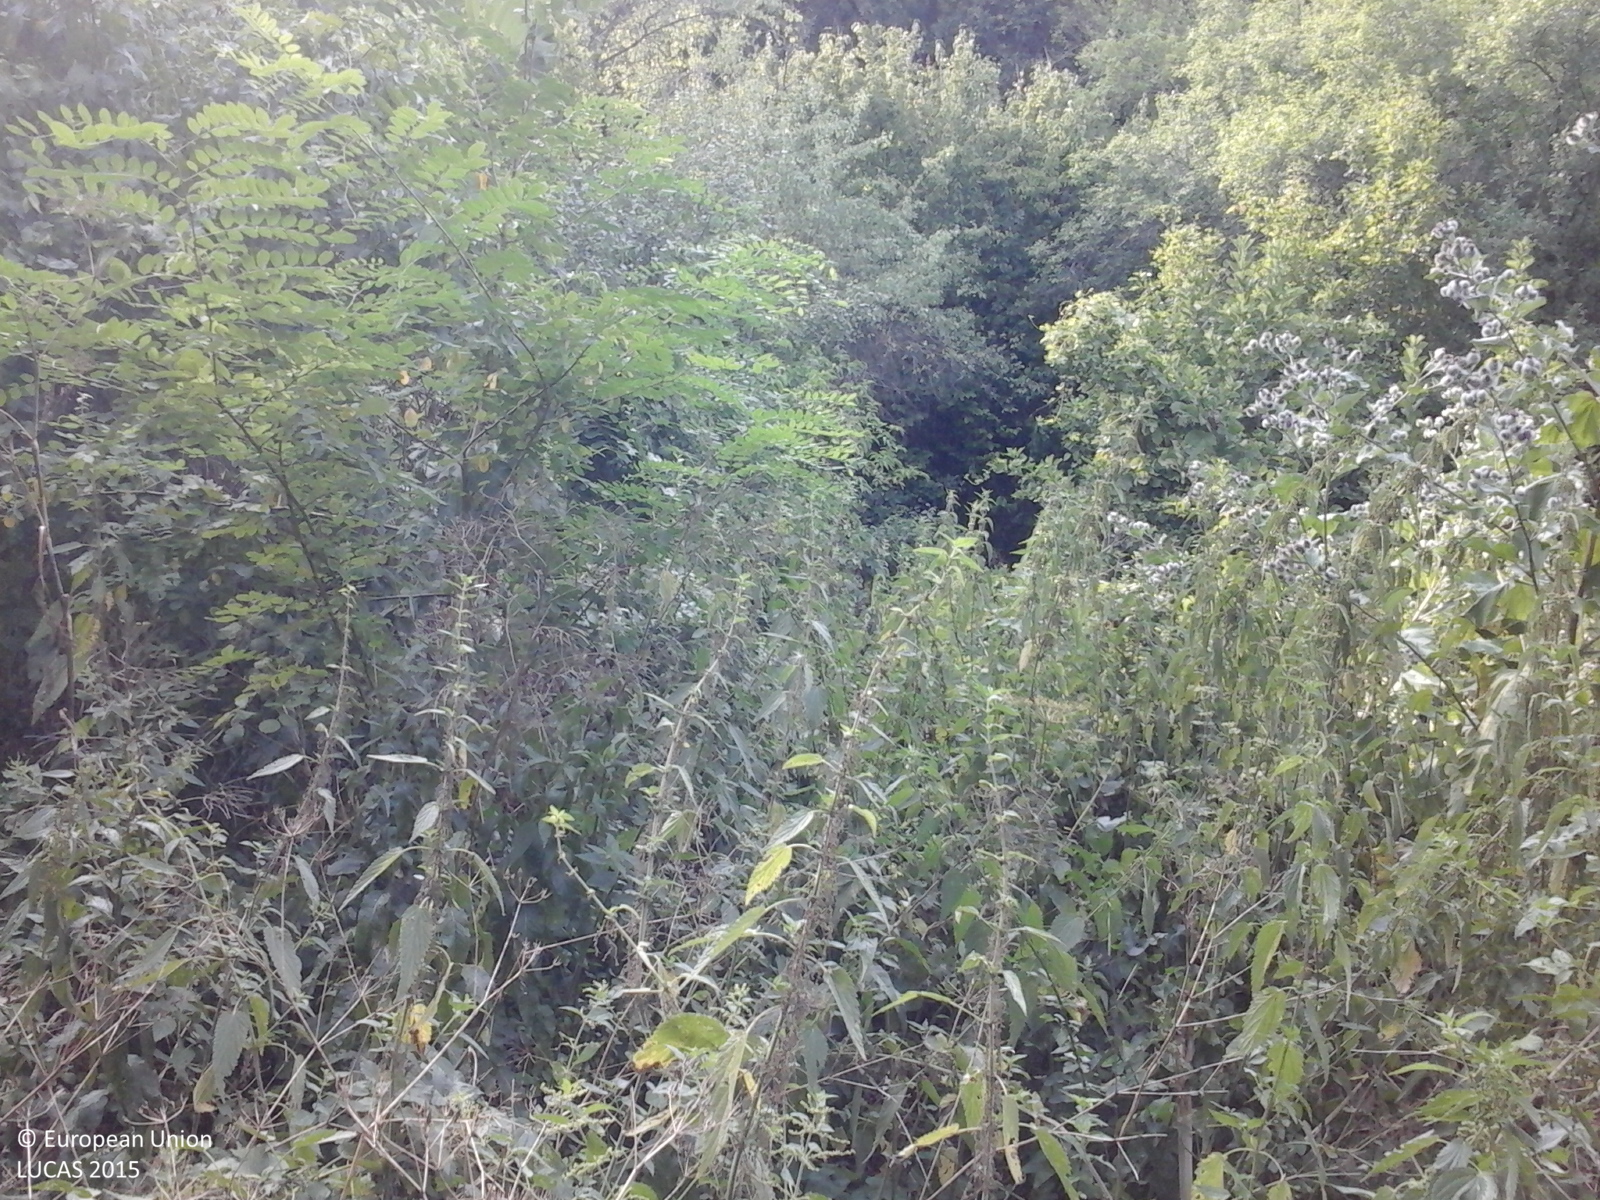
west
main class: Woodland
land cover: Broadleaved woodland
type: exotic forest
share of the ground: > 75 %
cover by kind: broadleaved forest trees 100 %
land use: Forestry
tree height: > 5 m
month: August
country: RO
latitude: 44.0012
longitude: 27.9723
